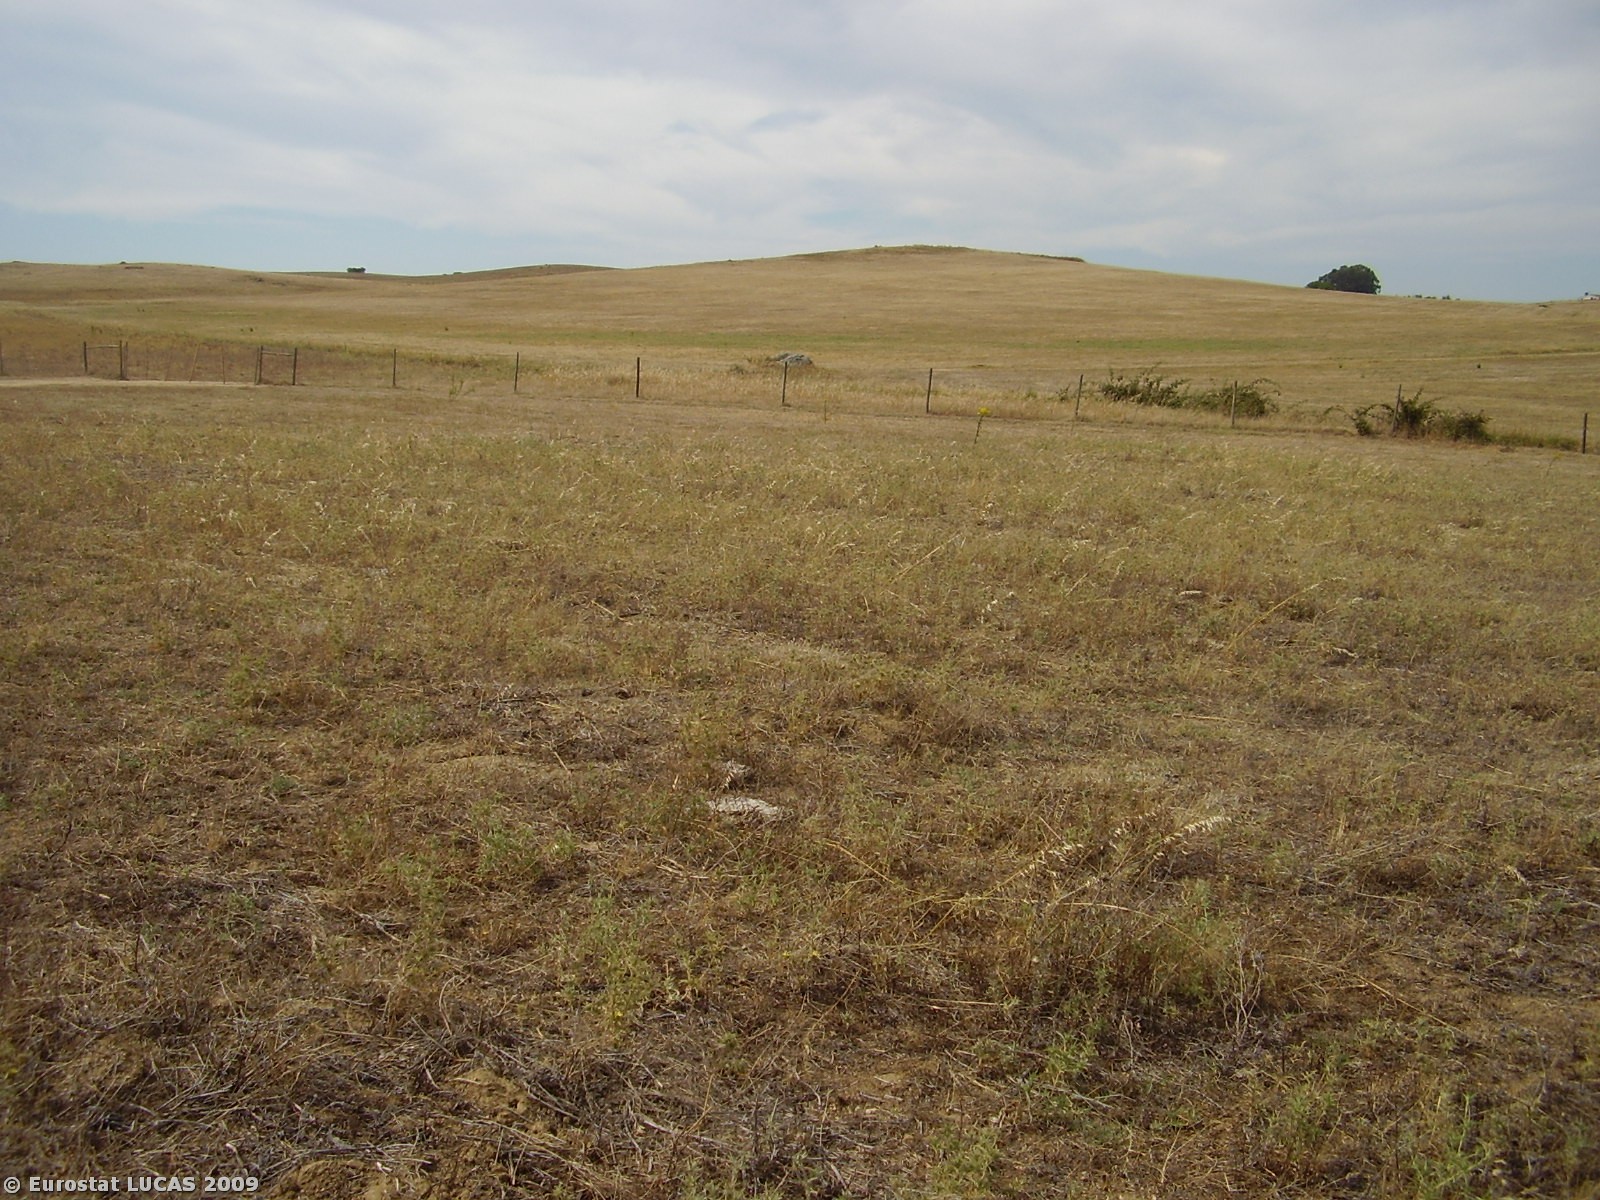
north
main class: Grassland
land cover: Grassland without tree/shrub cover
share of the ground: > 75 %
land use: Fallow land
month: July
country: PT
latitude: 38.6502
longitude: -7.8613
